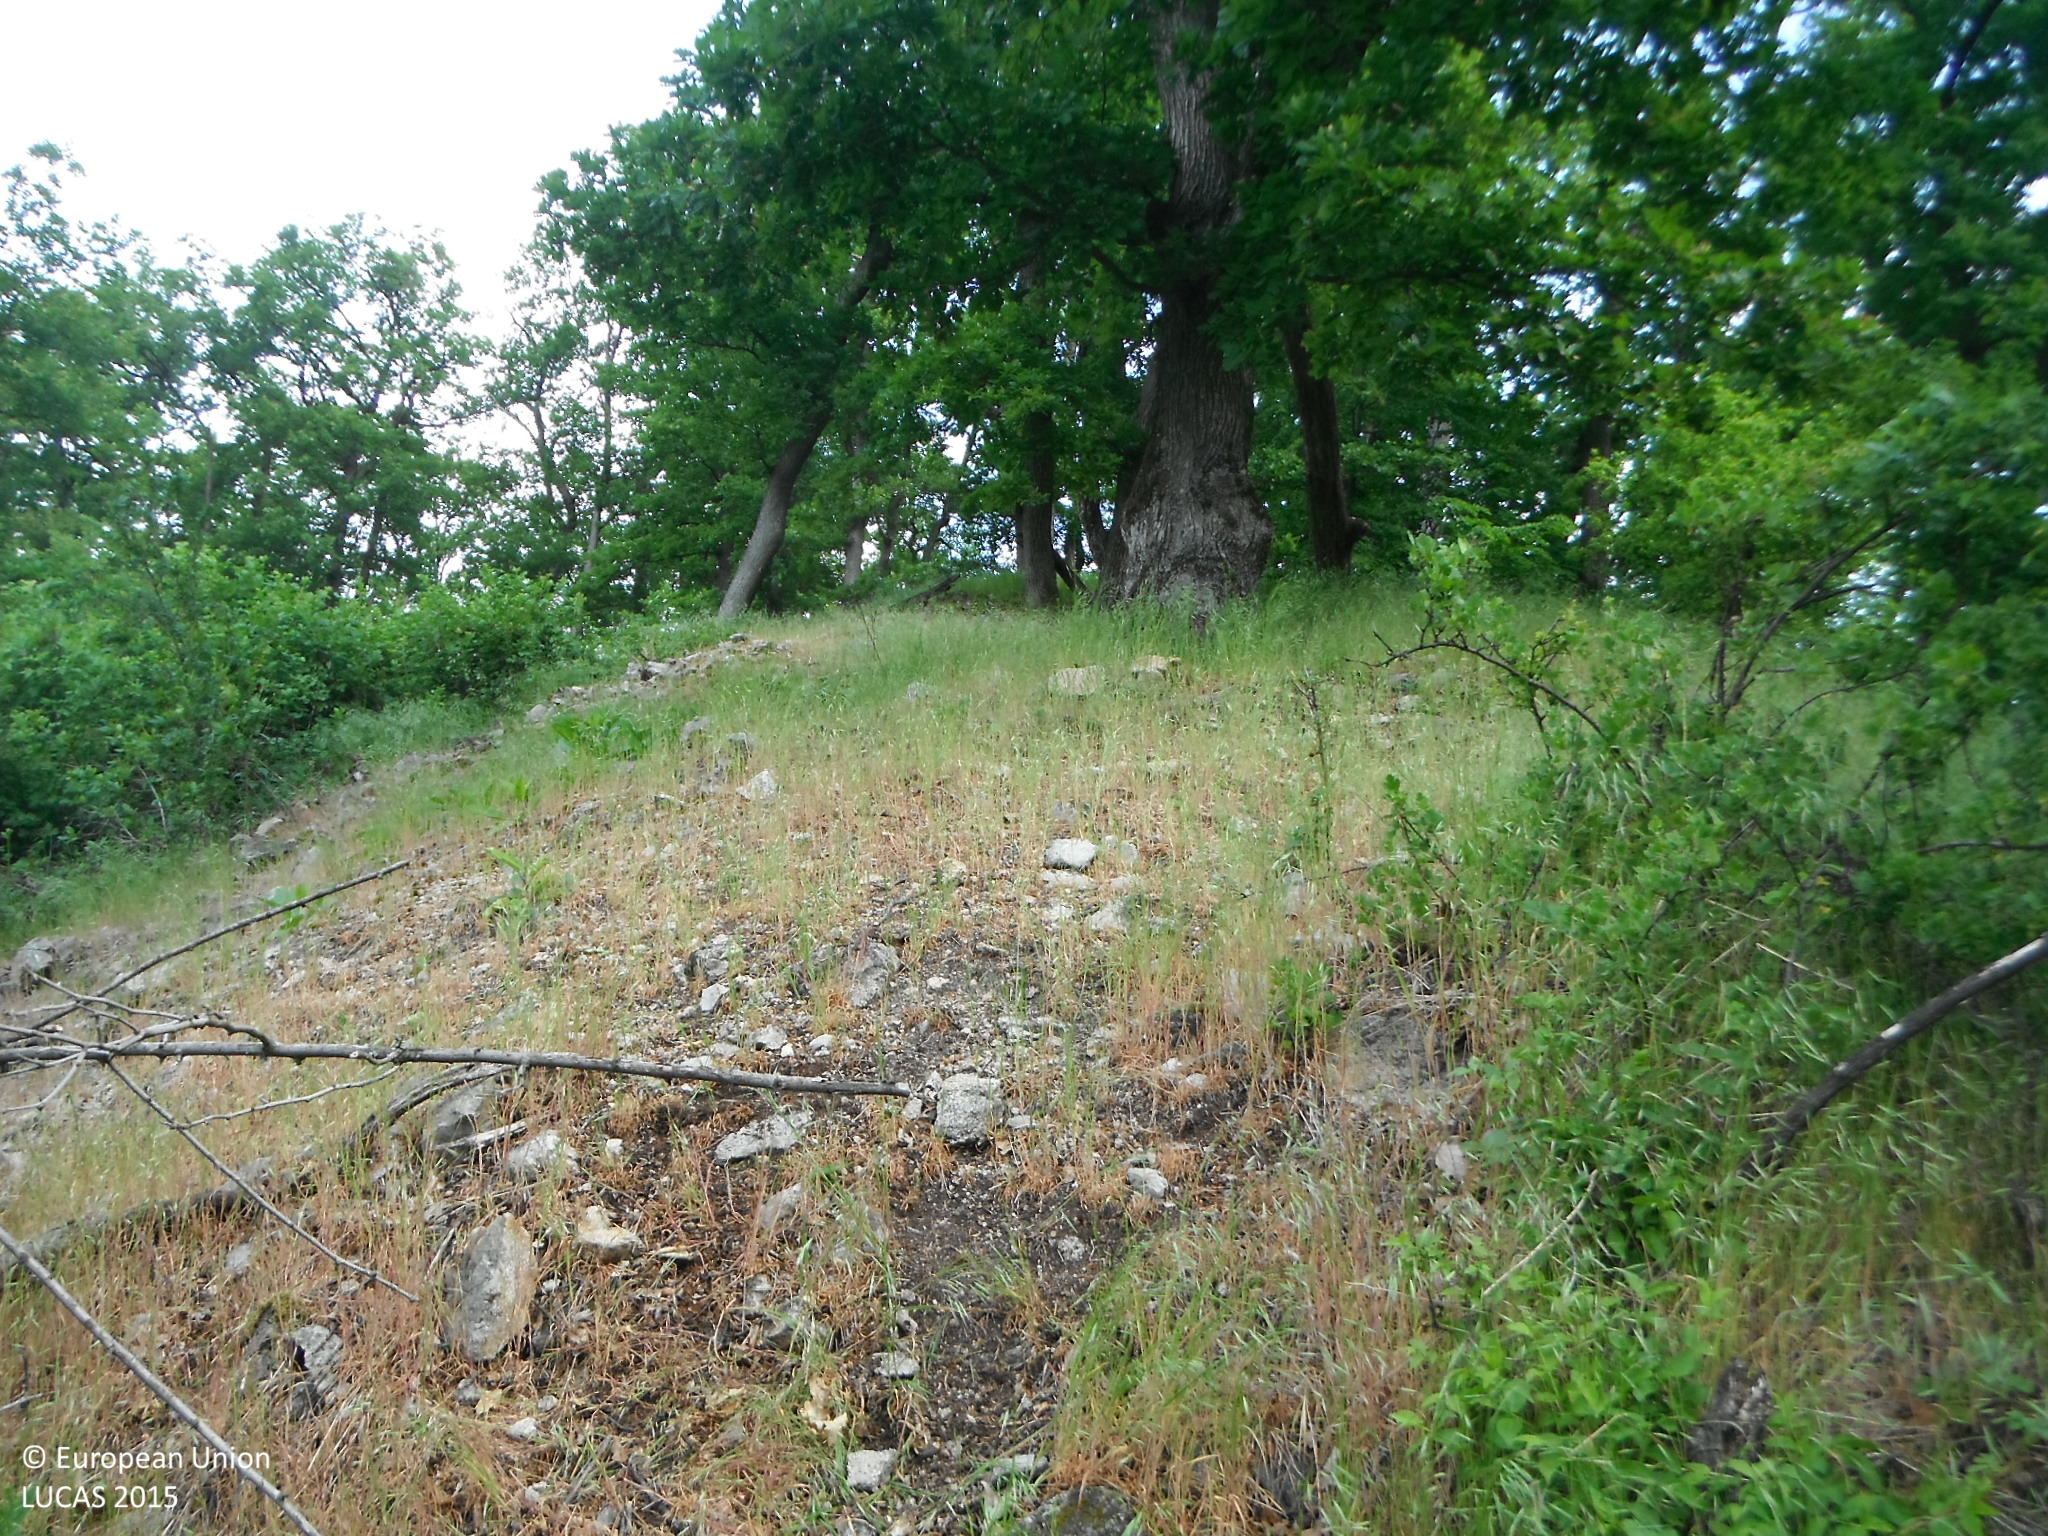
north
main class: Woodland
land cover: Broadleaved woodland
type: acidophilous oak and oak-birch forest
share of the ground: > 75 %
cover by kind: broadleaved forest trees 80 %, shrubs 10 %, herbaceous plants 10 %
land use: Forestry
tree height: > 5 m
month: May
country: SK
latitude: 48.2418
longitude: 17.1856
